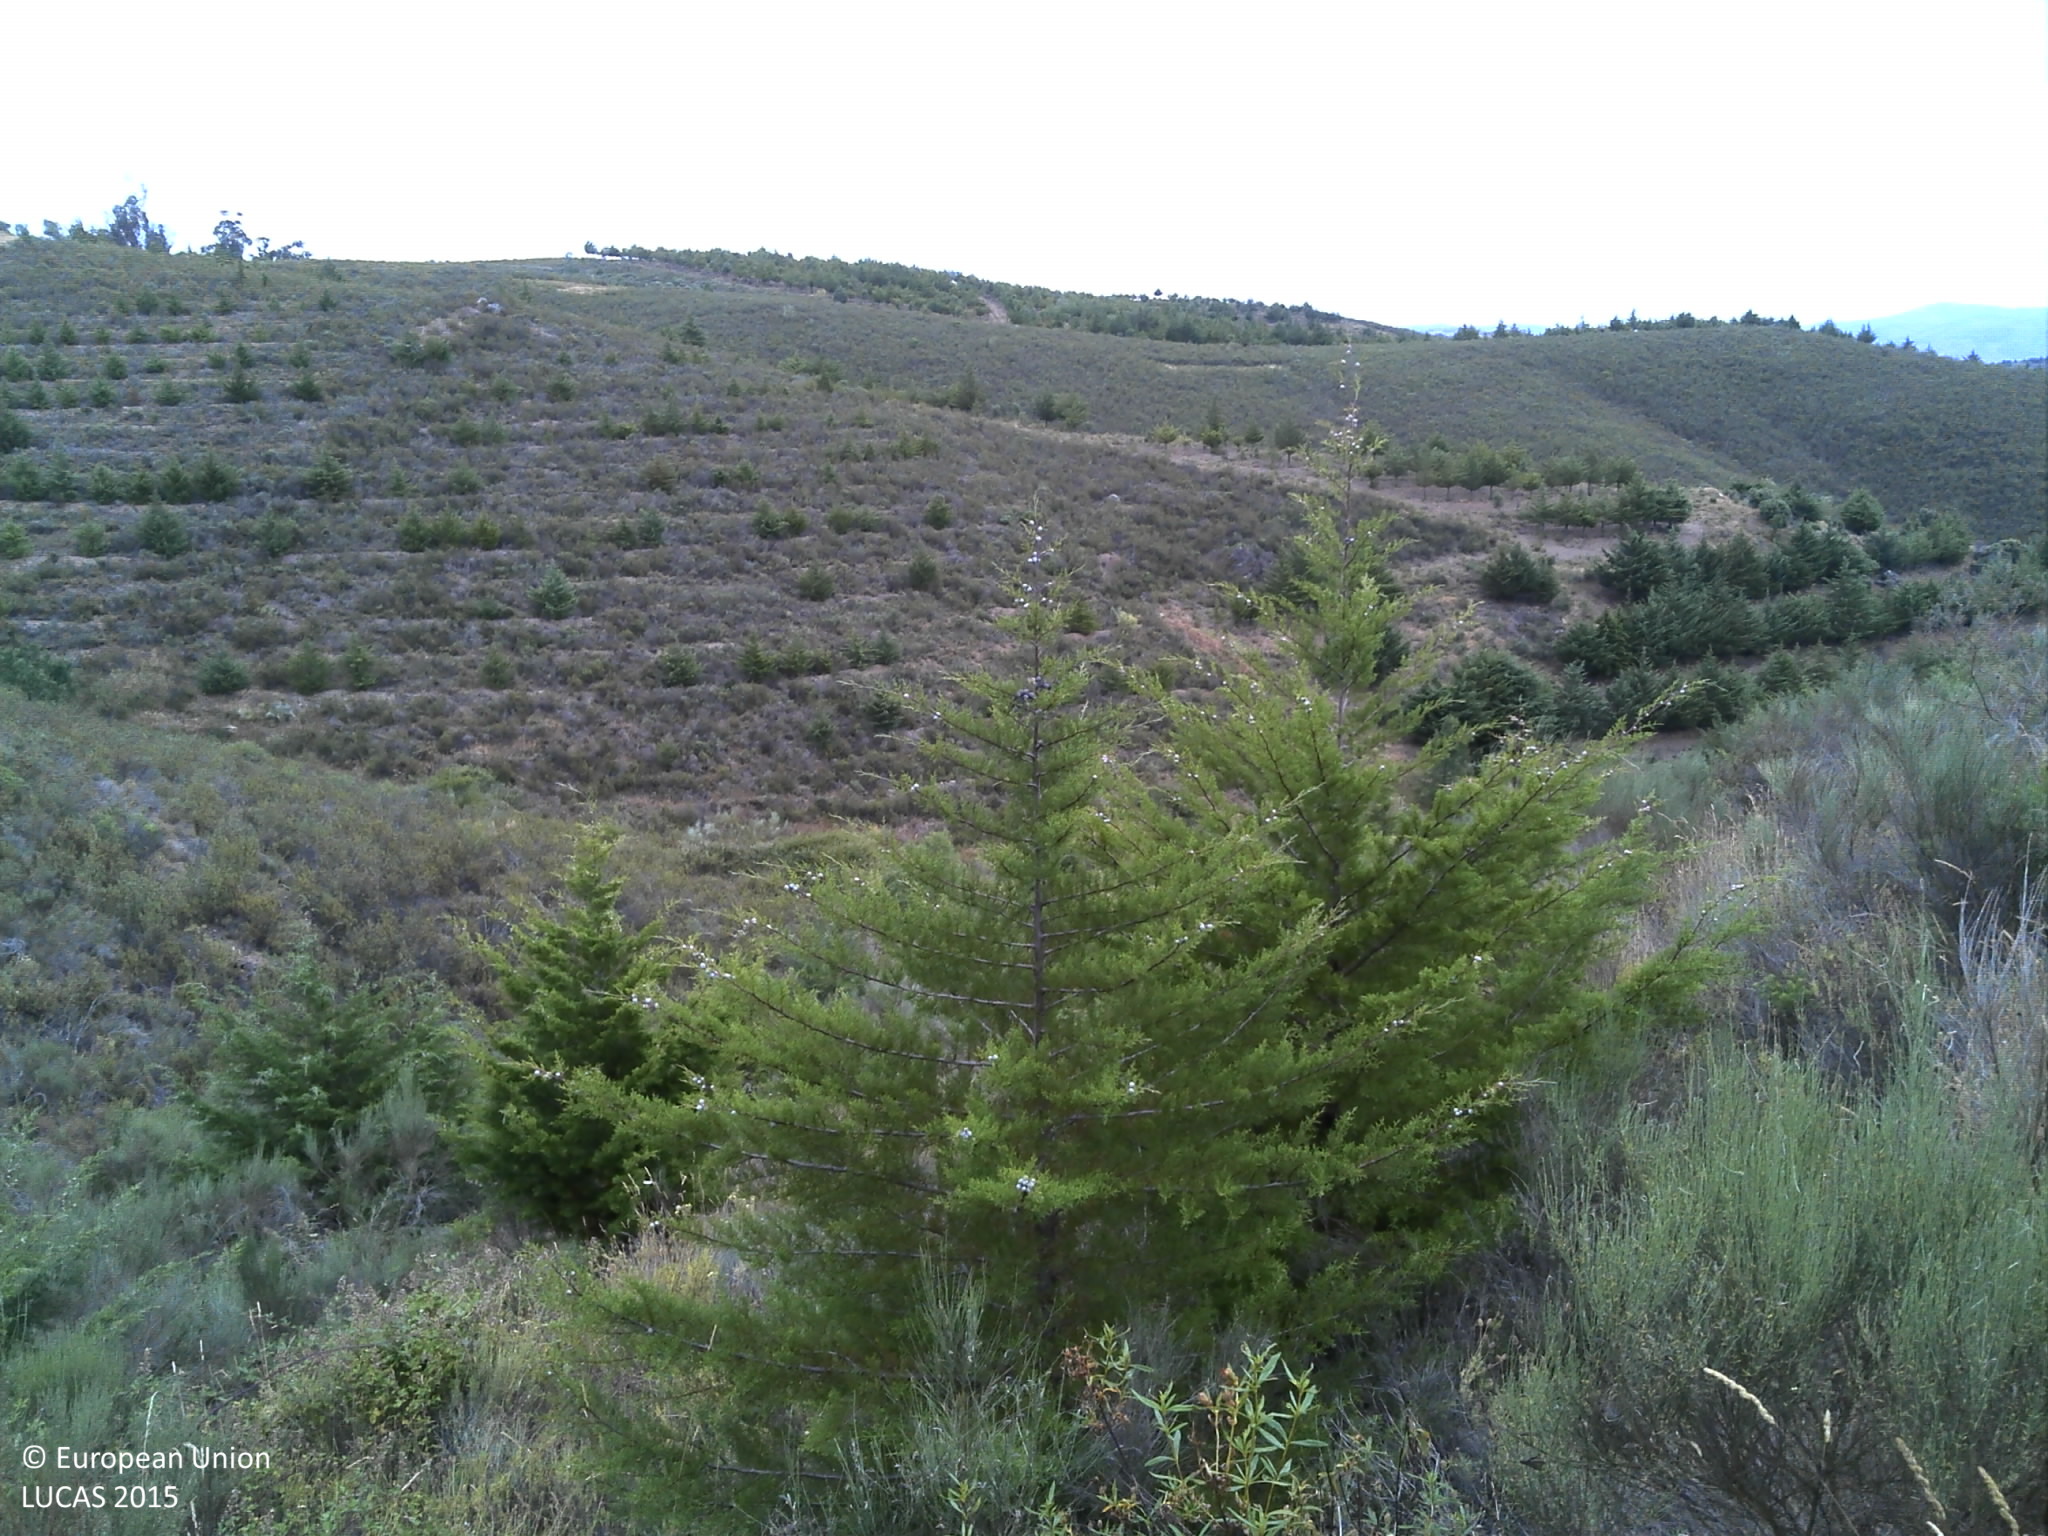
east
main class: Shrubland
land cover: Shrubland with sparse tree cover
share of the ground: > 75 %
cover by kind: shrubs 95 %, coniferous forest trees 5 %
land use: Abandoned areas
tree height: < 5 m
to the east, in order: Shrubland with sparse tree cover; Shrubland without tree cover; Rivers and streams; Shrubland with sparse tree cover; Tracks; Other mixed woodland; Tracks; Shrubland without tree cover
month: June
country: PT
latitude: 41.2855
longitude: -6.9578
